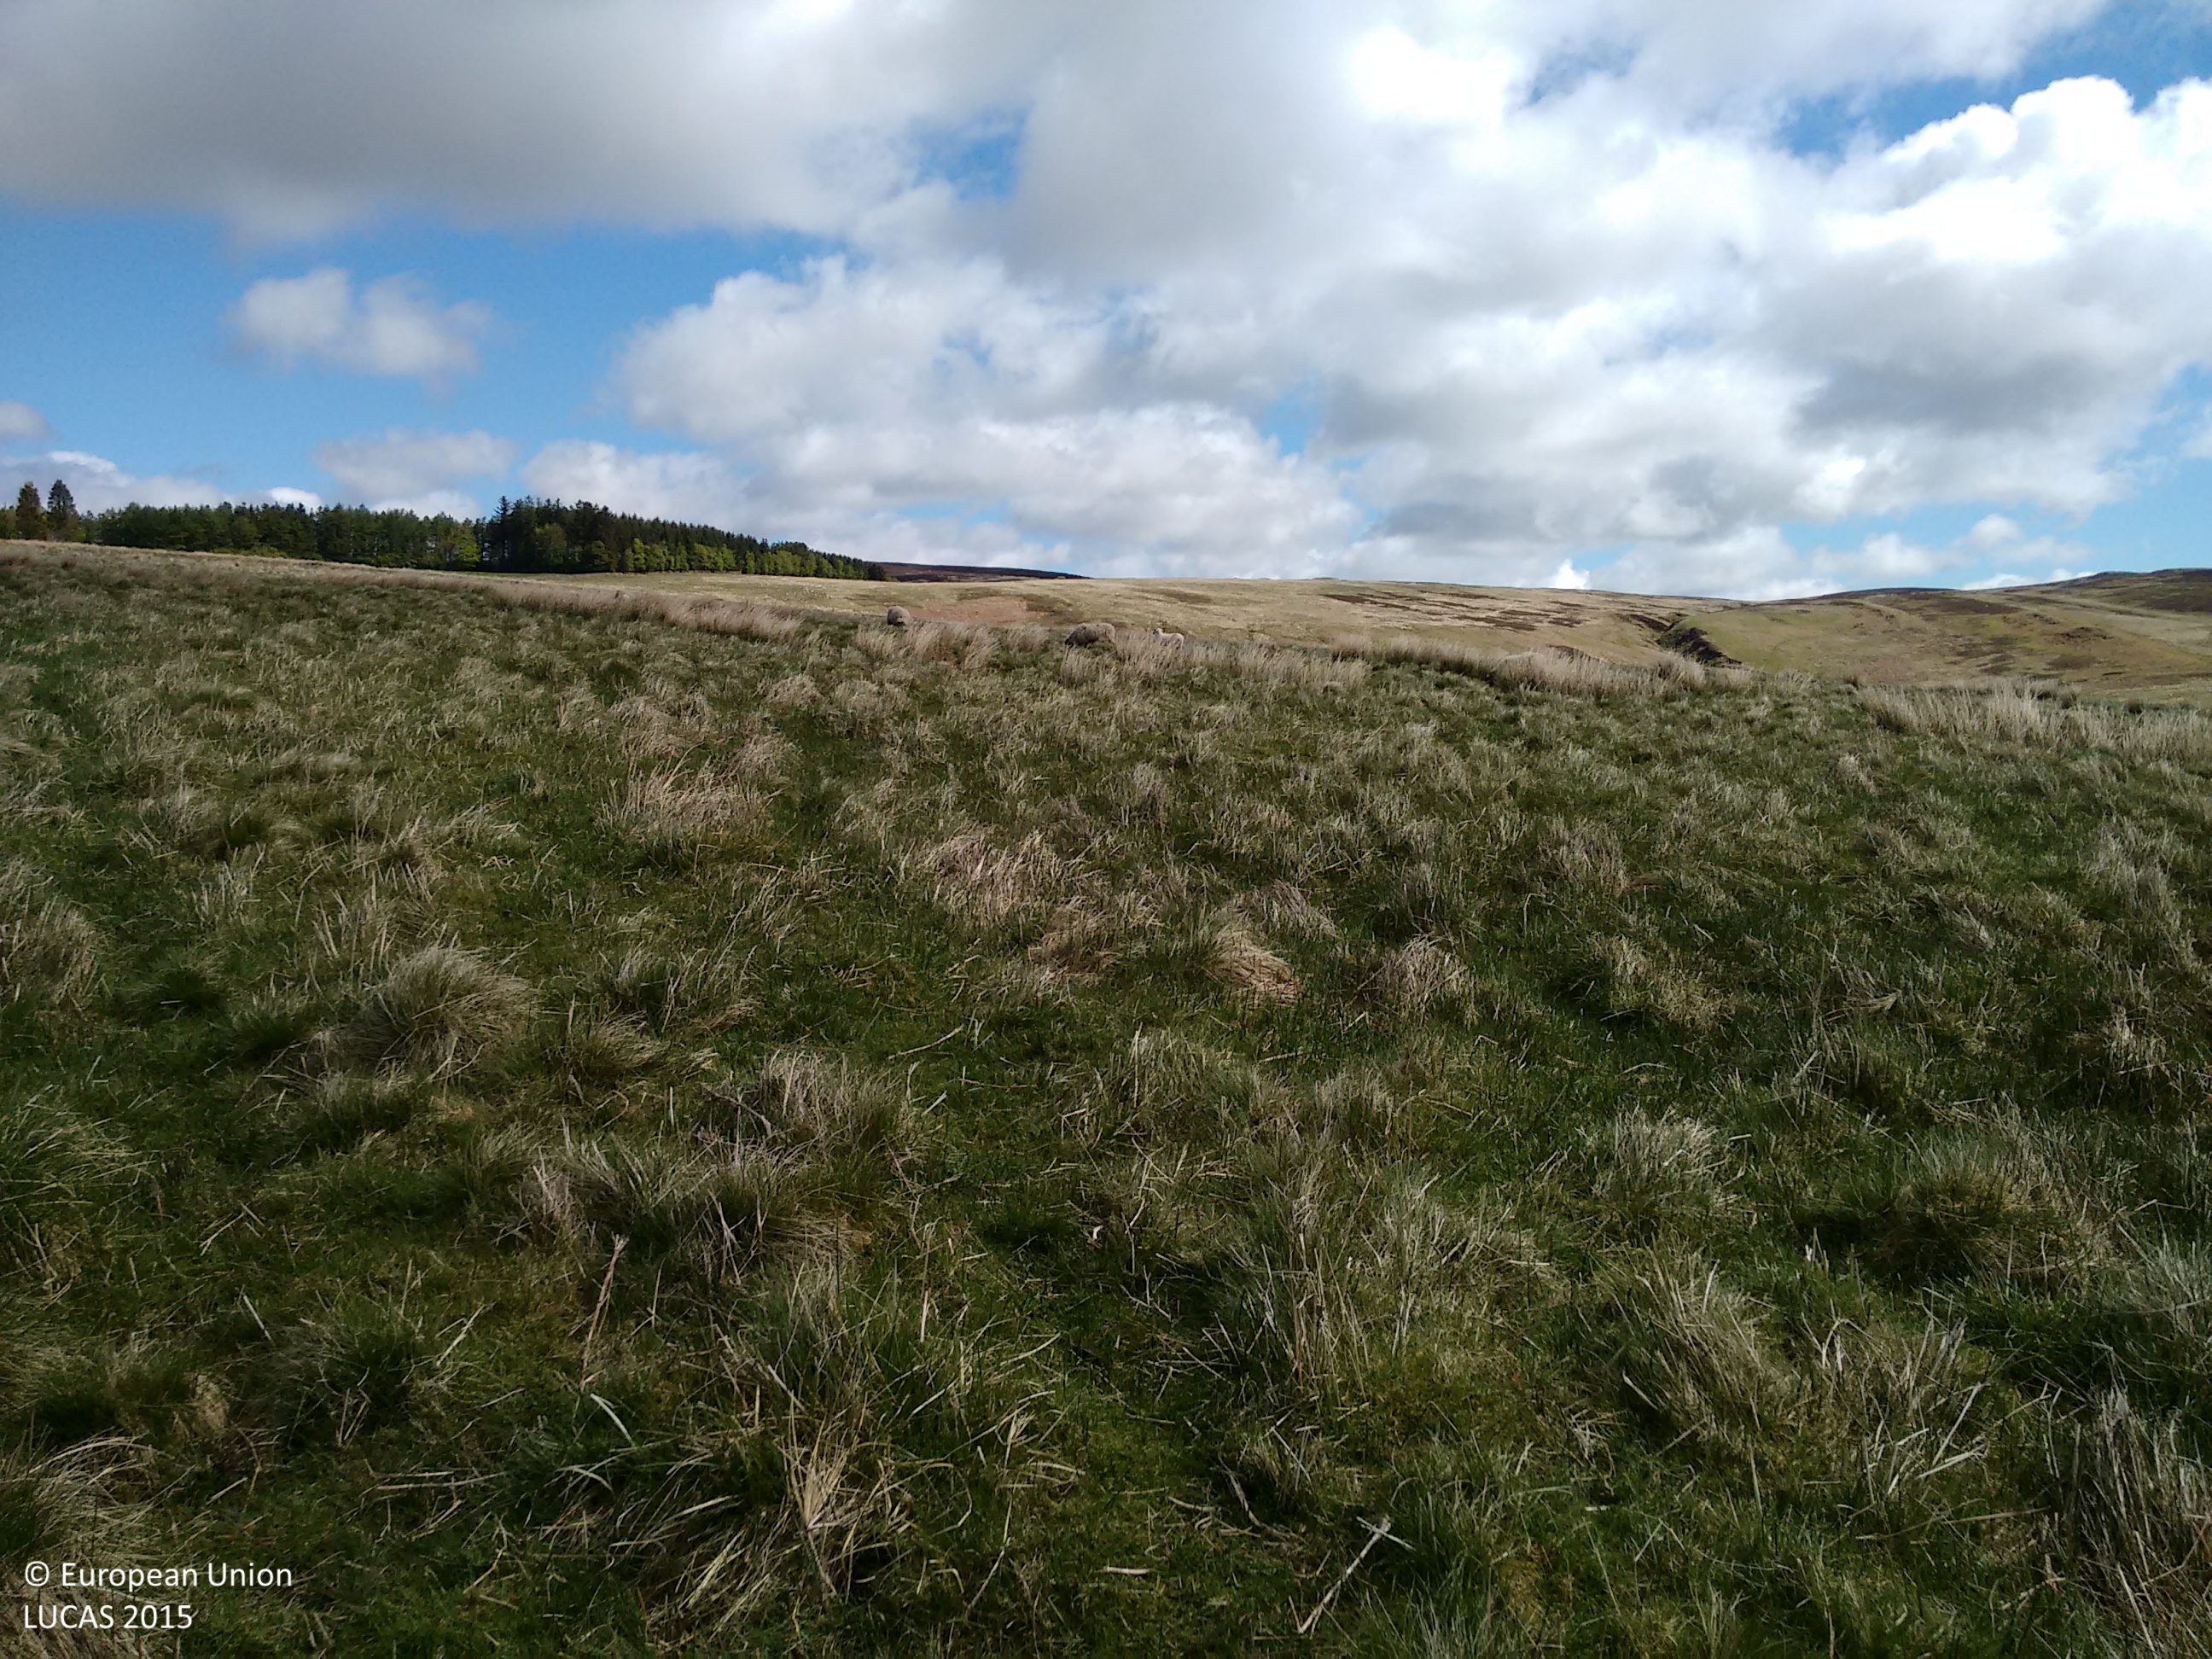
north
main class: Grassland
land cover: Grassland without tree/shrub cover
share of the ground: > 75 %
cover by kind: herbaceous plants 100 %
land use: Agriculture (excluding fallow land and kitchen gardens)
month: May
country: GB
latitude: 55.2107
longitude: -2.3011
